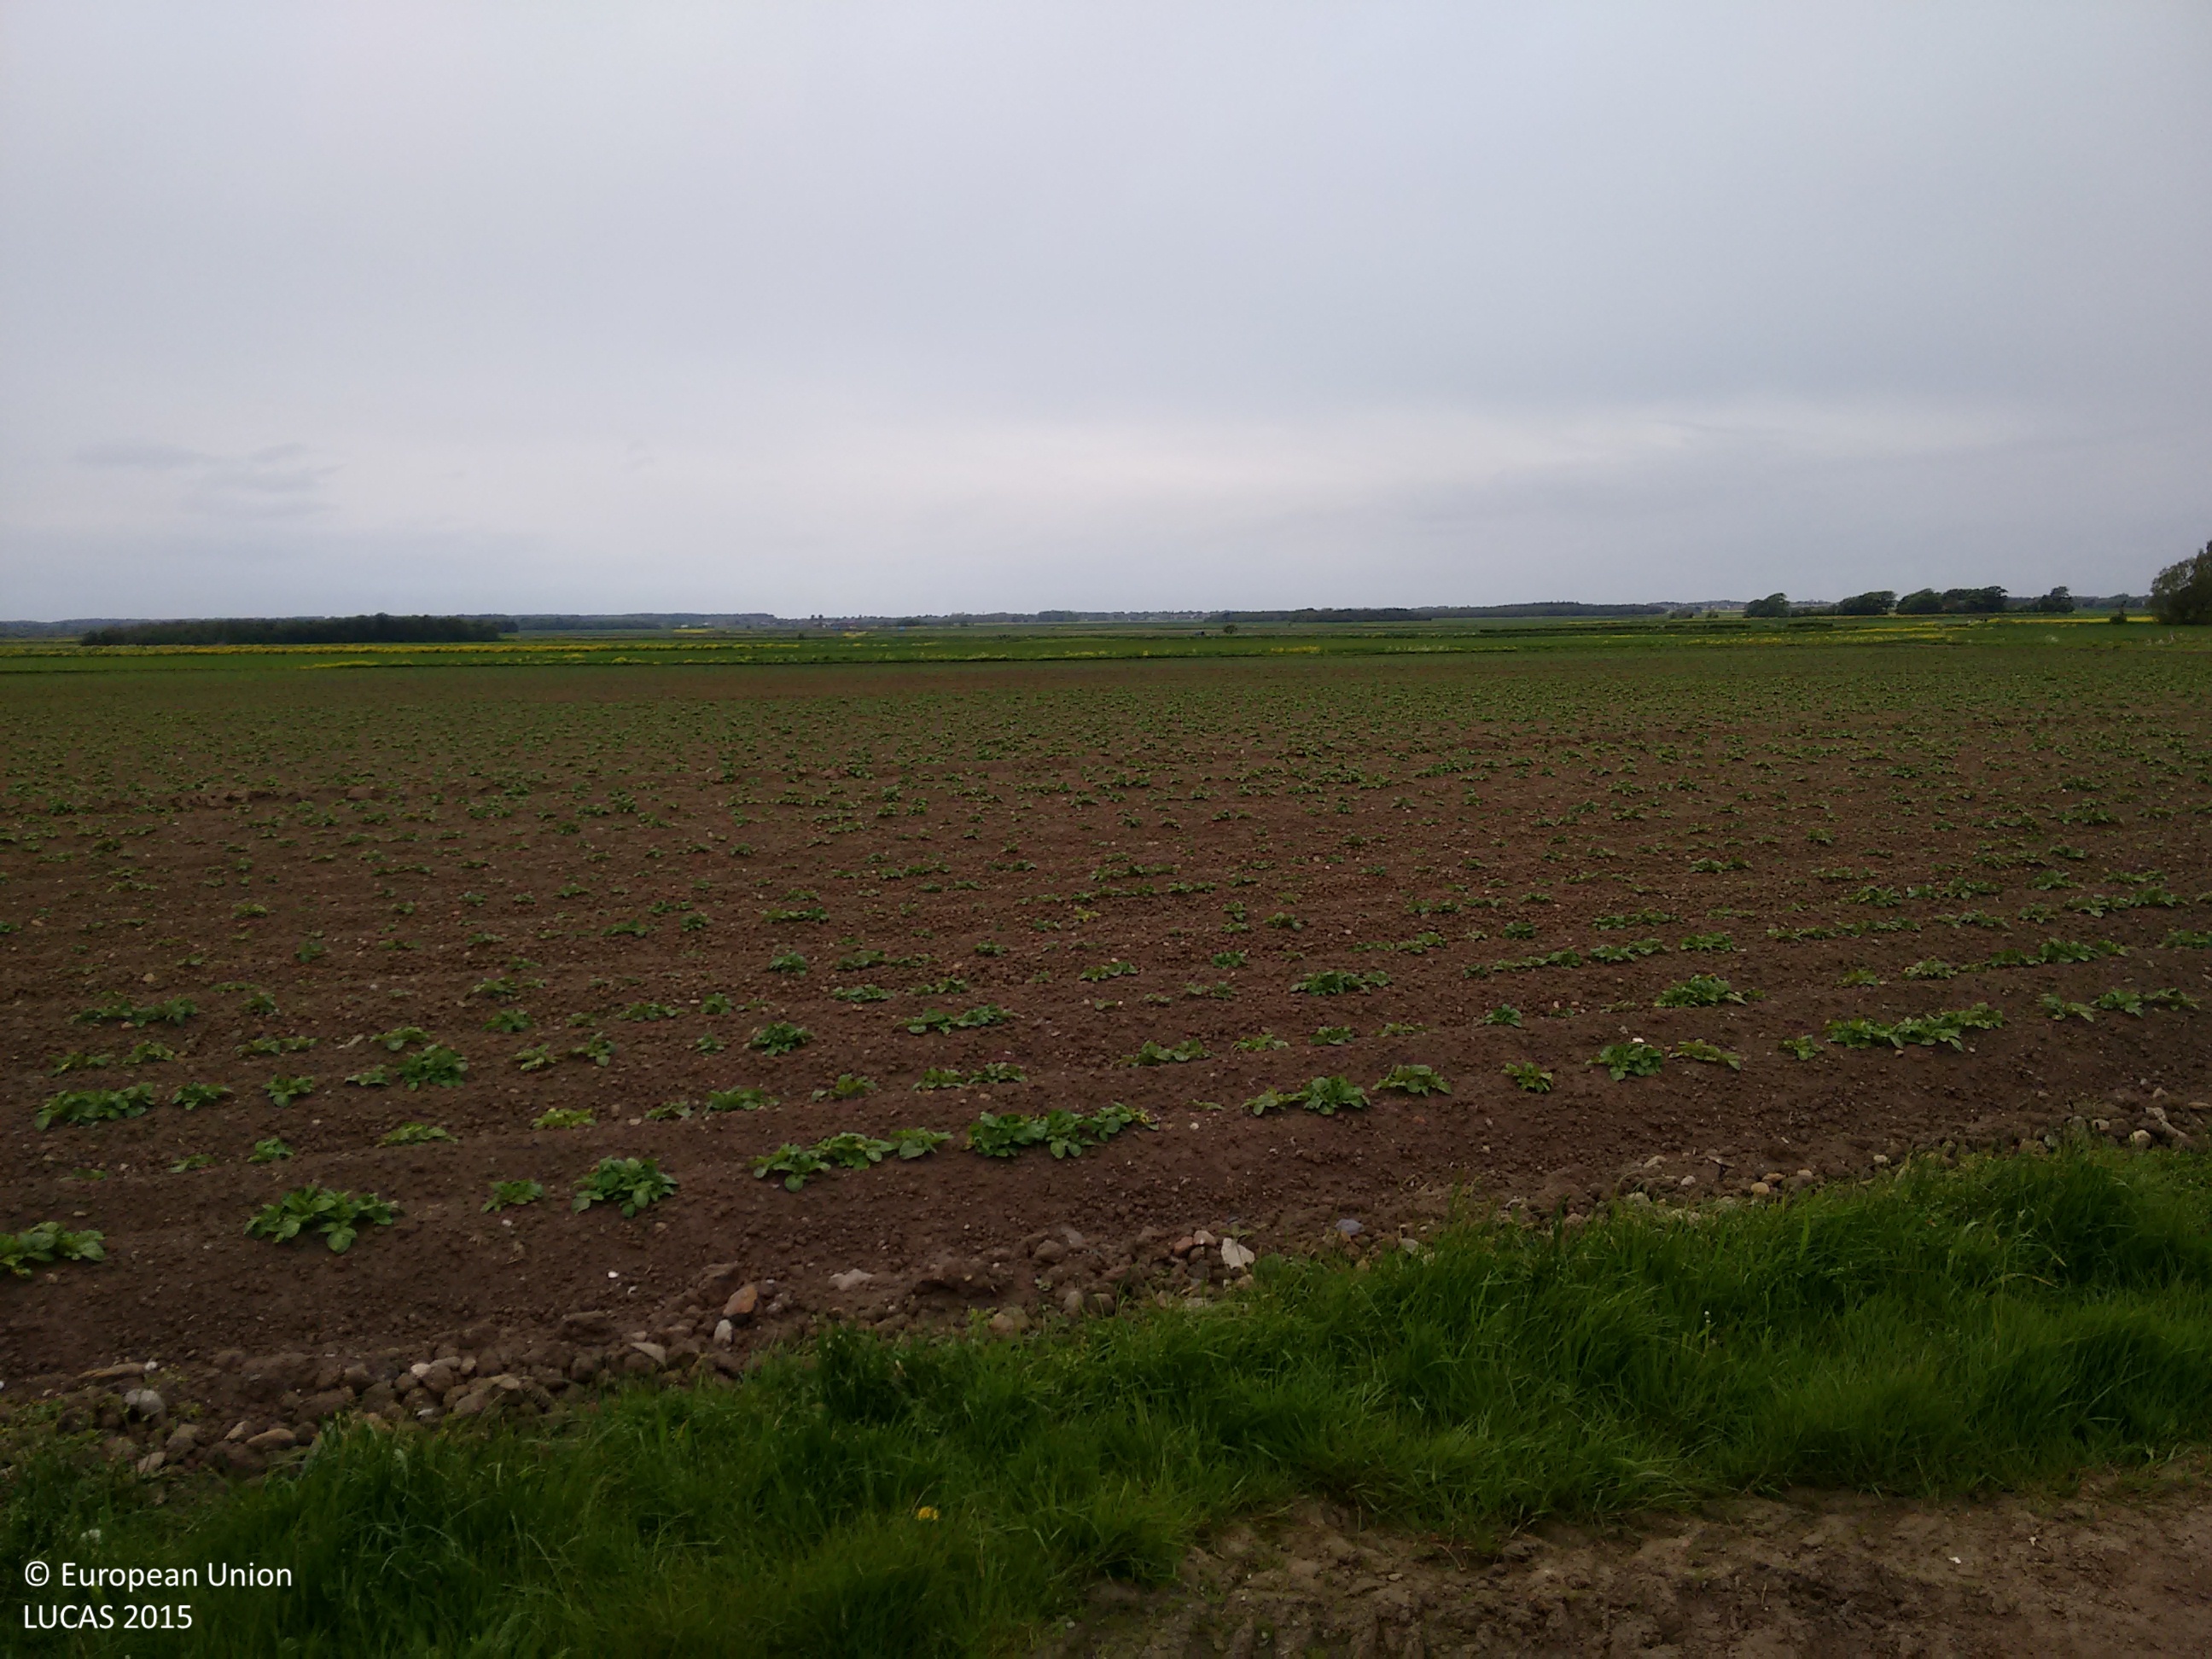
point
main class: Cropland
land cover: Potatoes
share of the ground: 10 - 25 %
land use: Agriculture (excluding fallow land and kitchen gardens)
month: May
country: GB
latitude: 53.5736
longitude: -2.9857
